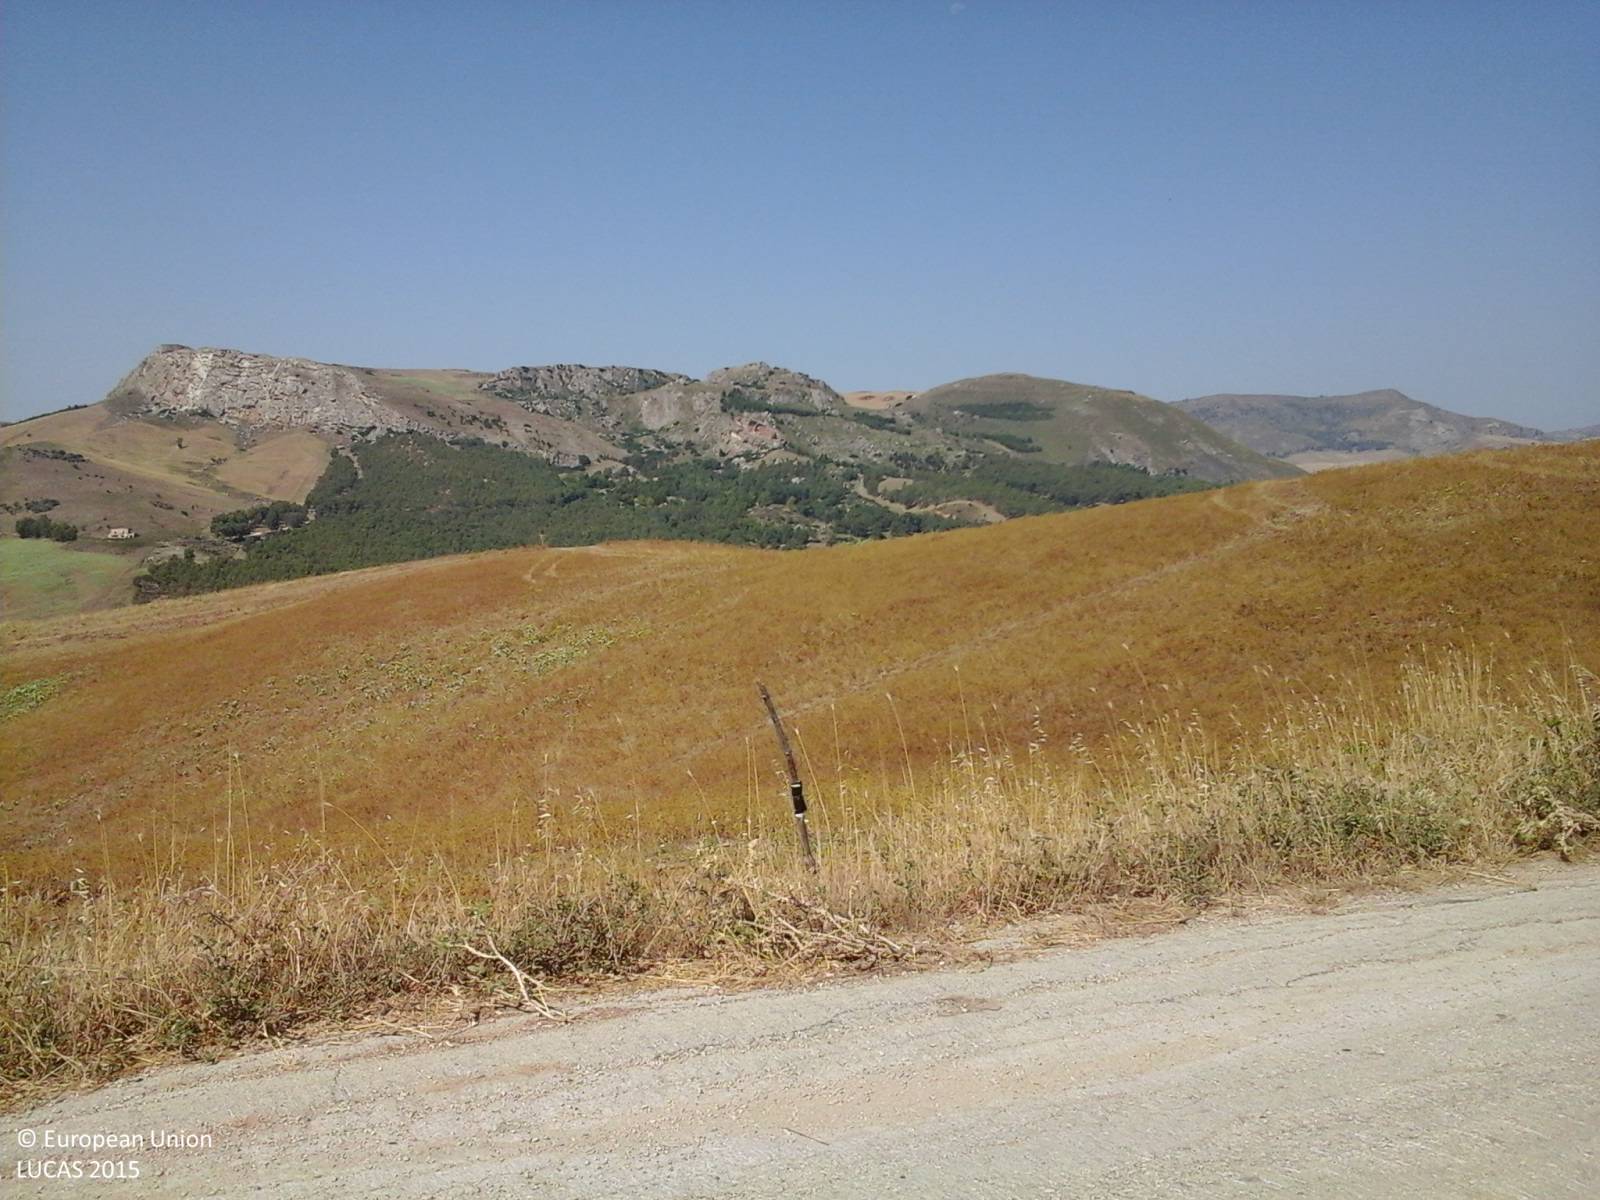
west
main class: Grassland
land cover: Grassland without tree/shrub cover
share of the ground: > 75 %
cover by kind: herbaceous plants 100 %
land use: Semi-natural and natural areas not in use
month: July
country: IT
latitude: 37.7864
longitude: 13.1449
